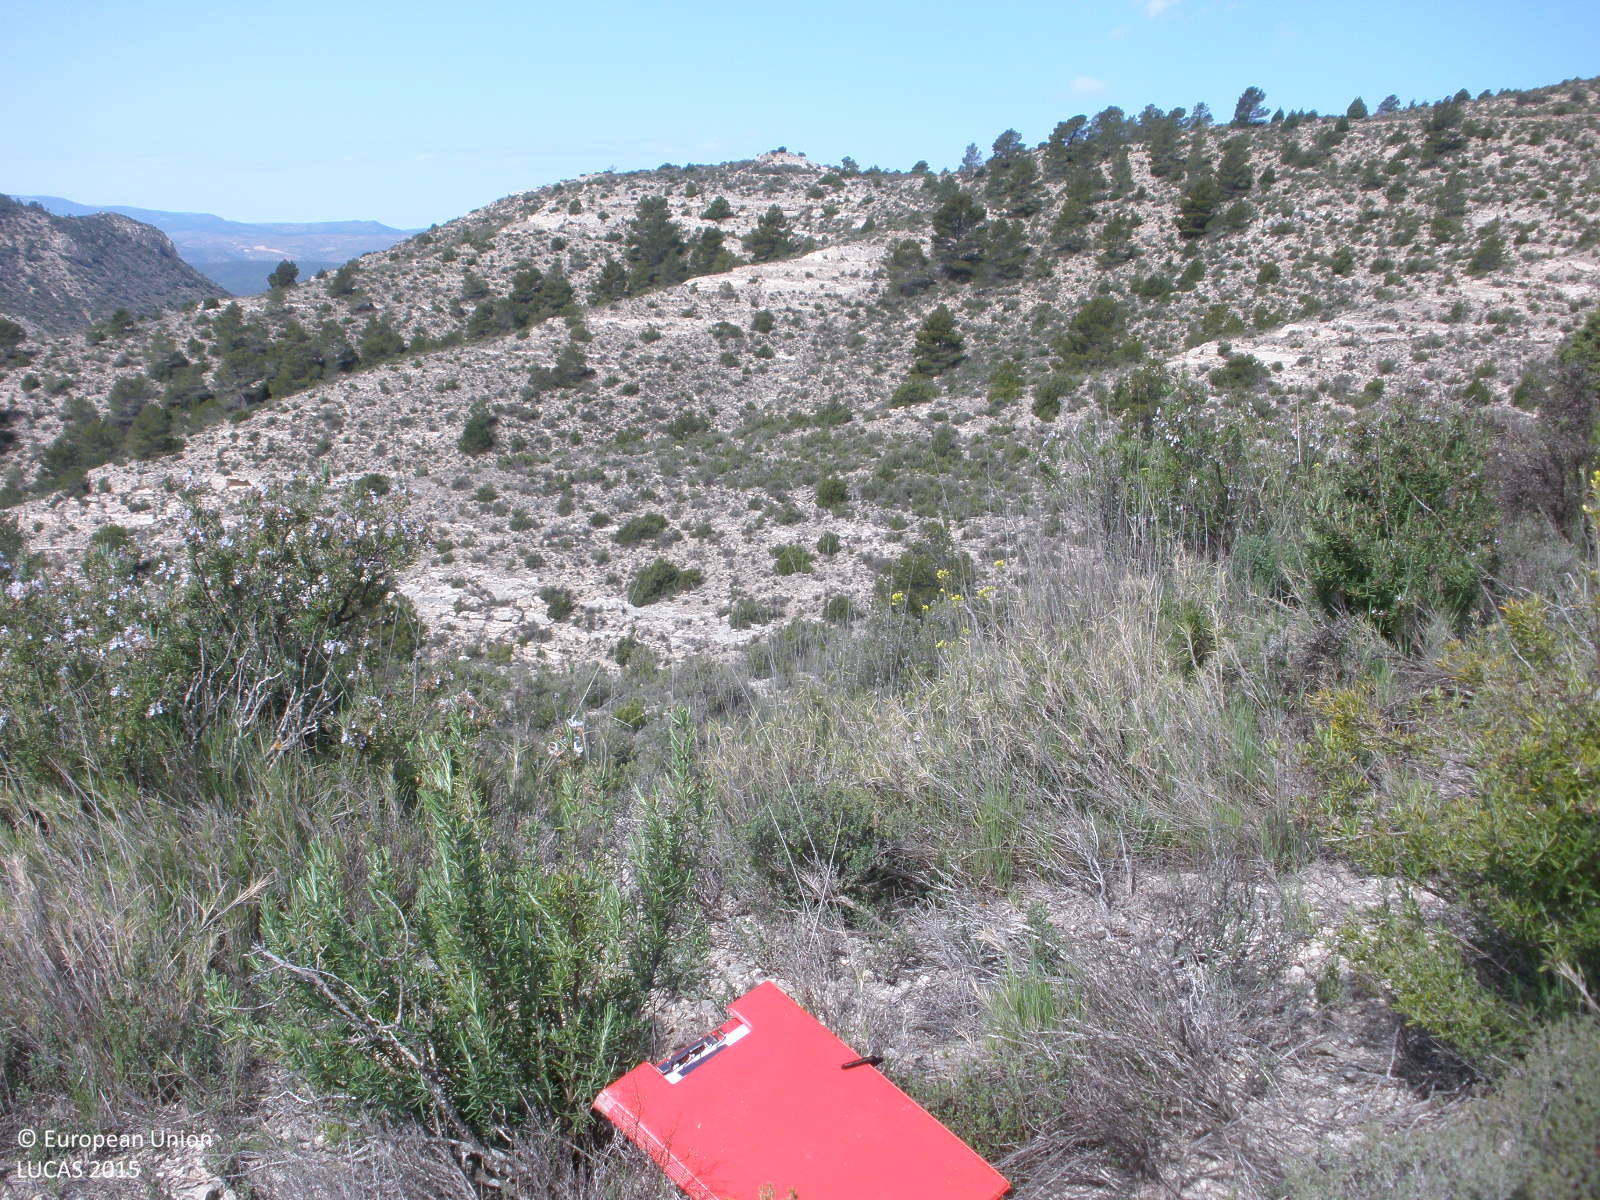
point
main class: Shrubland
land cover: Shrubland without tree cover
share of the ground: > 75 %
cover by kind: shrubs 80 %, consolidated bare surface 20 %
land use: Semi-natural and natural areas not in use
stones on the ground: 25 - 50 %
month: April
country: ES
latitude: 40.1534
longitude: -1.1971
